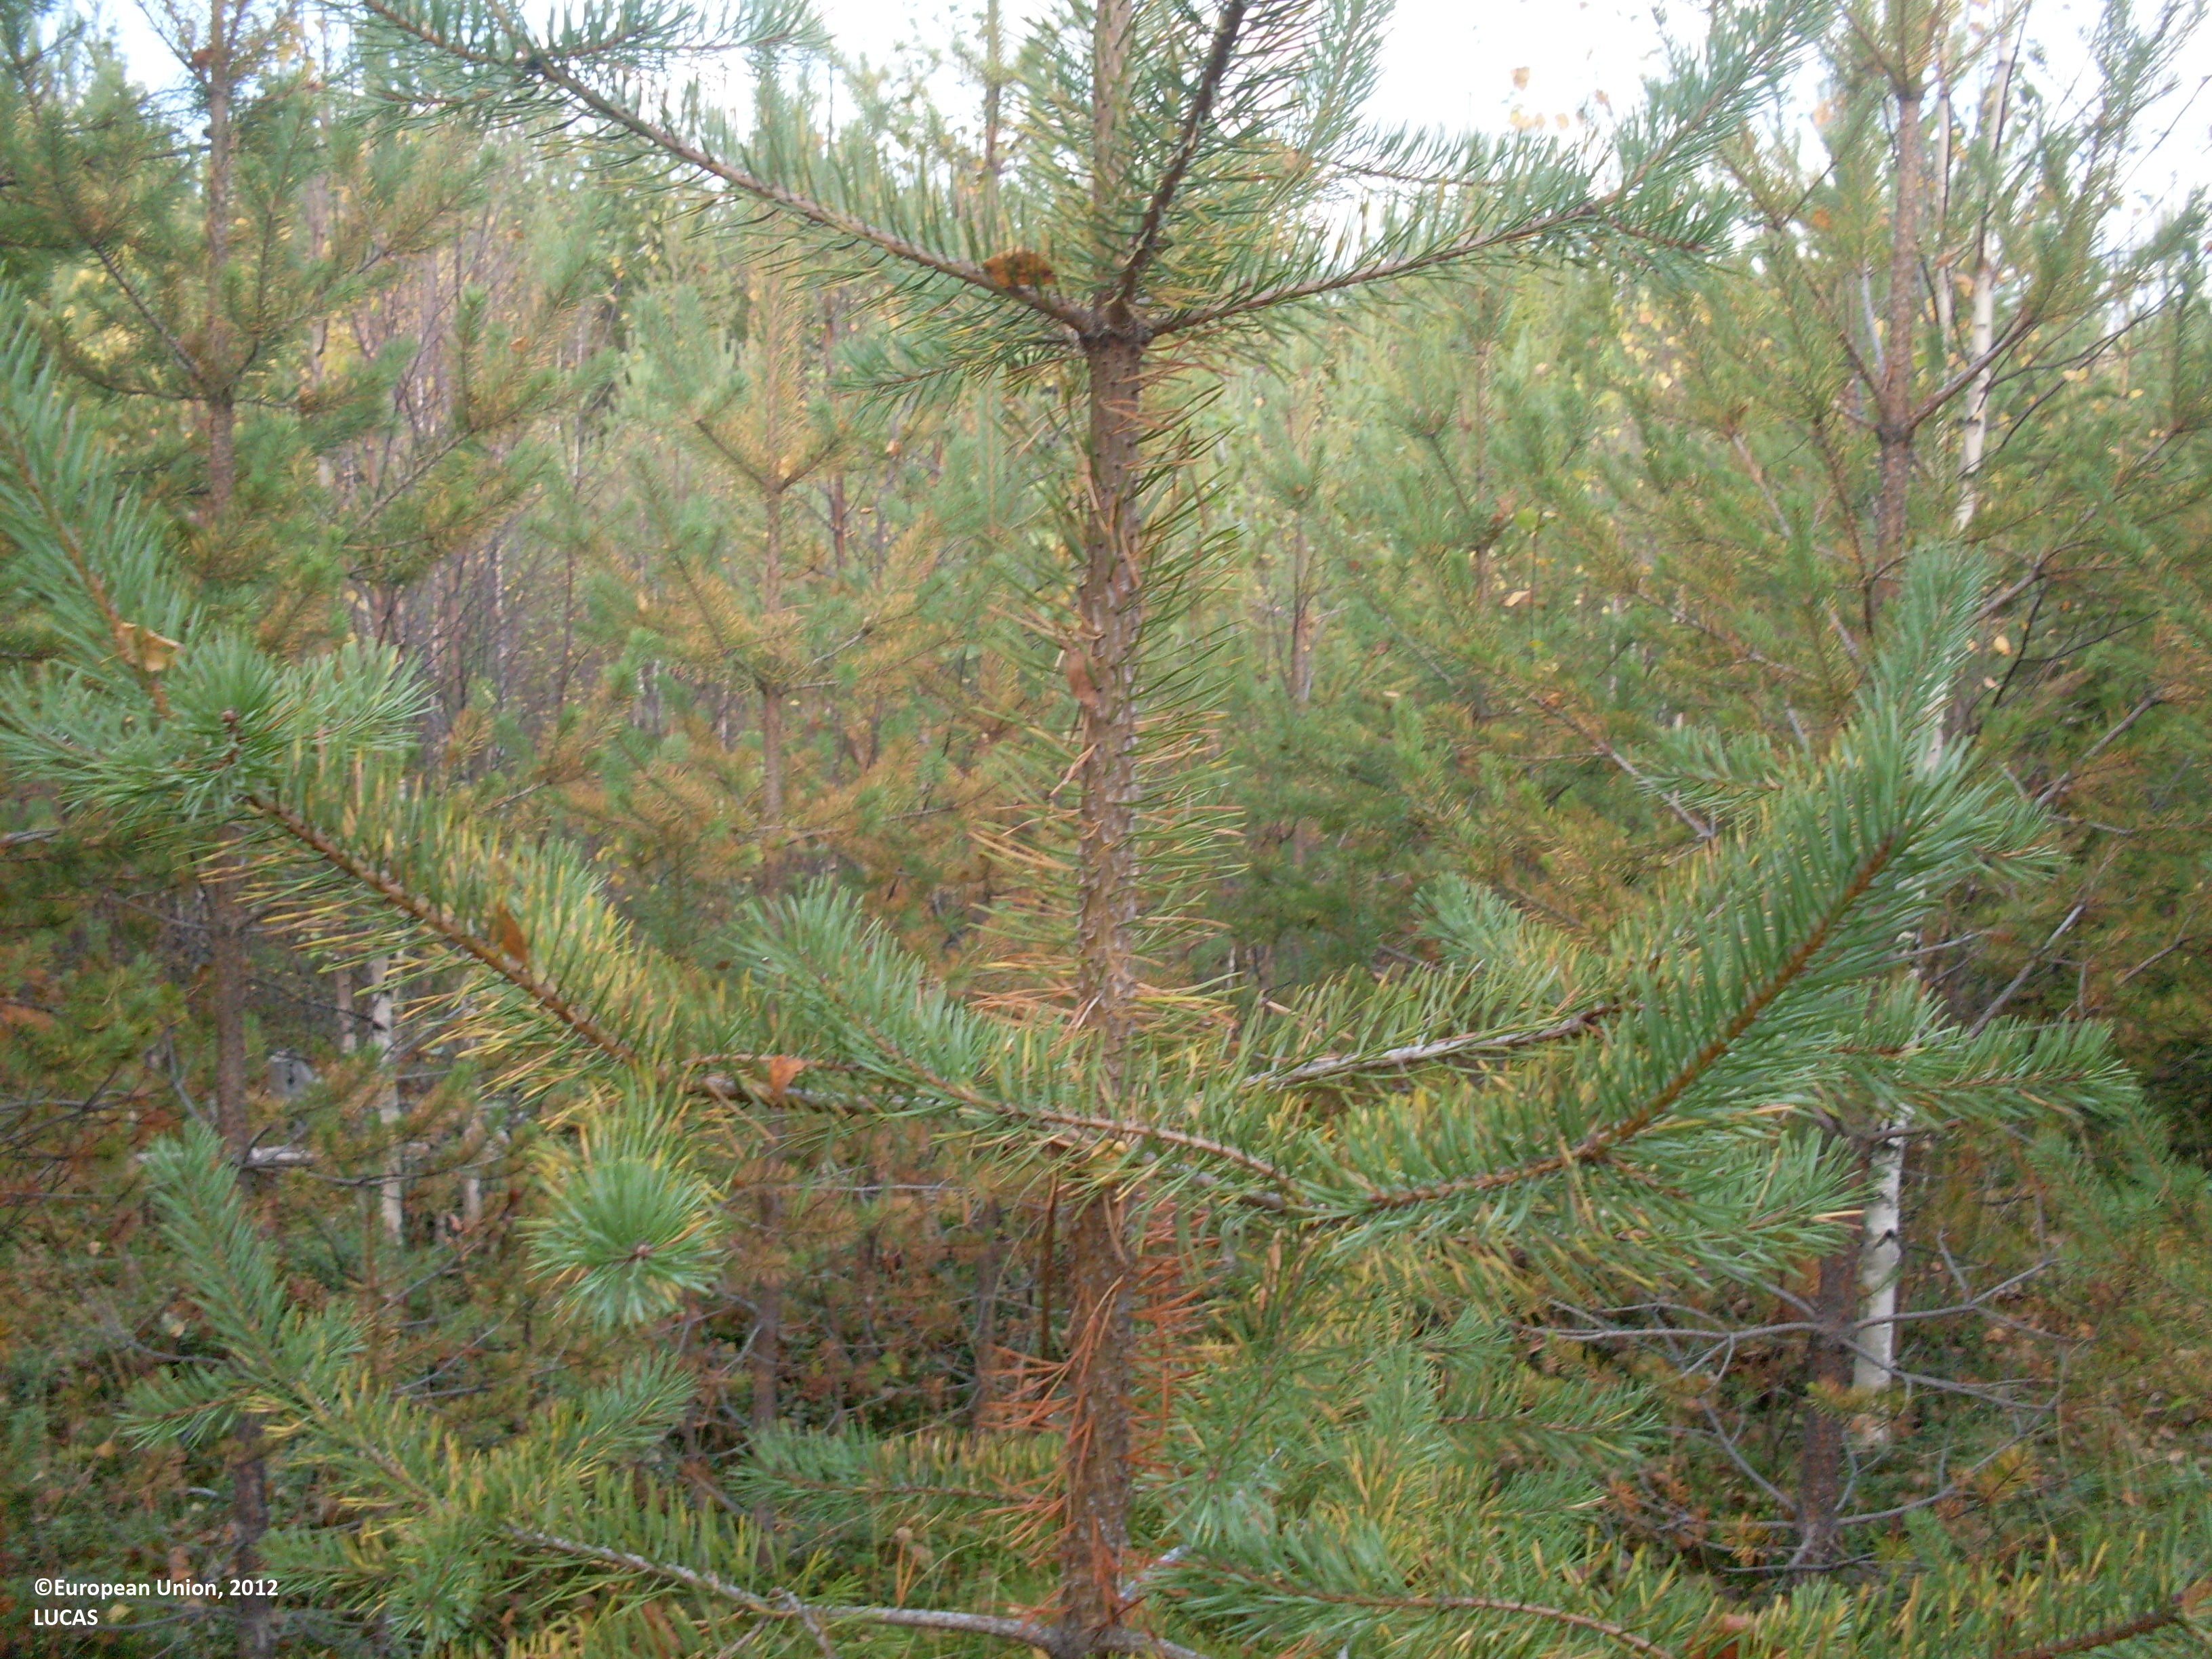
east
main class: Woodland
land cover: Pine dominated coniferous woodland
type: boreal forest
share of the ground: 50 - 75 %
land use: Forestry
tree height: < 5 m
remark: Nursery
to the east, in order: Pine dominated coniferous woodland; Pine dominated mixed woodland; Grass margins; Ditches and canals; Grass margins; Paved roads, cycling and walking lanes; Grass margins; Ditches and canals; Grass margins; Pine dominated mixed woodland; Pine dominated coniferous woodland
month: September
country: FI
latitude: 64.4112
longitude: 28.3716
